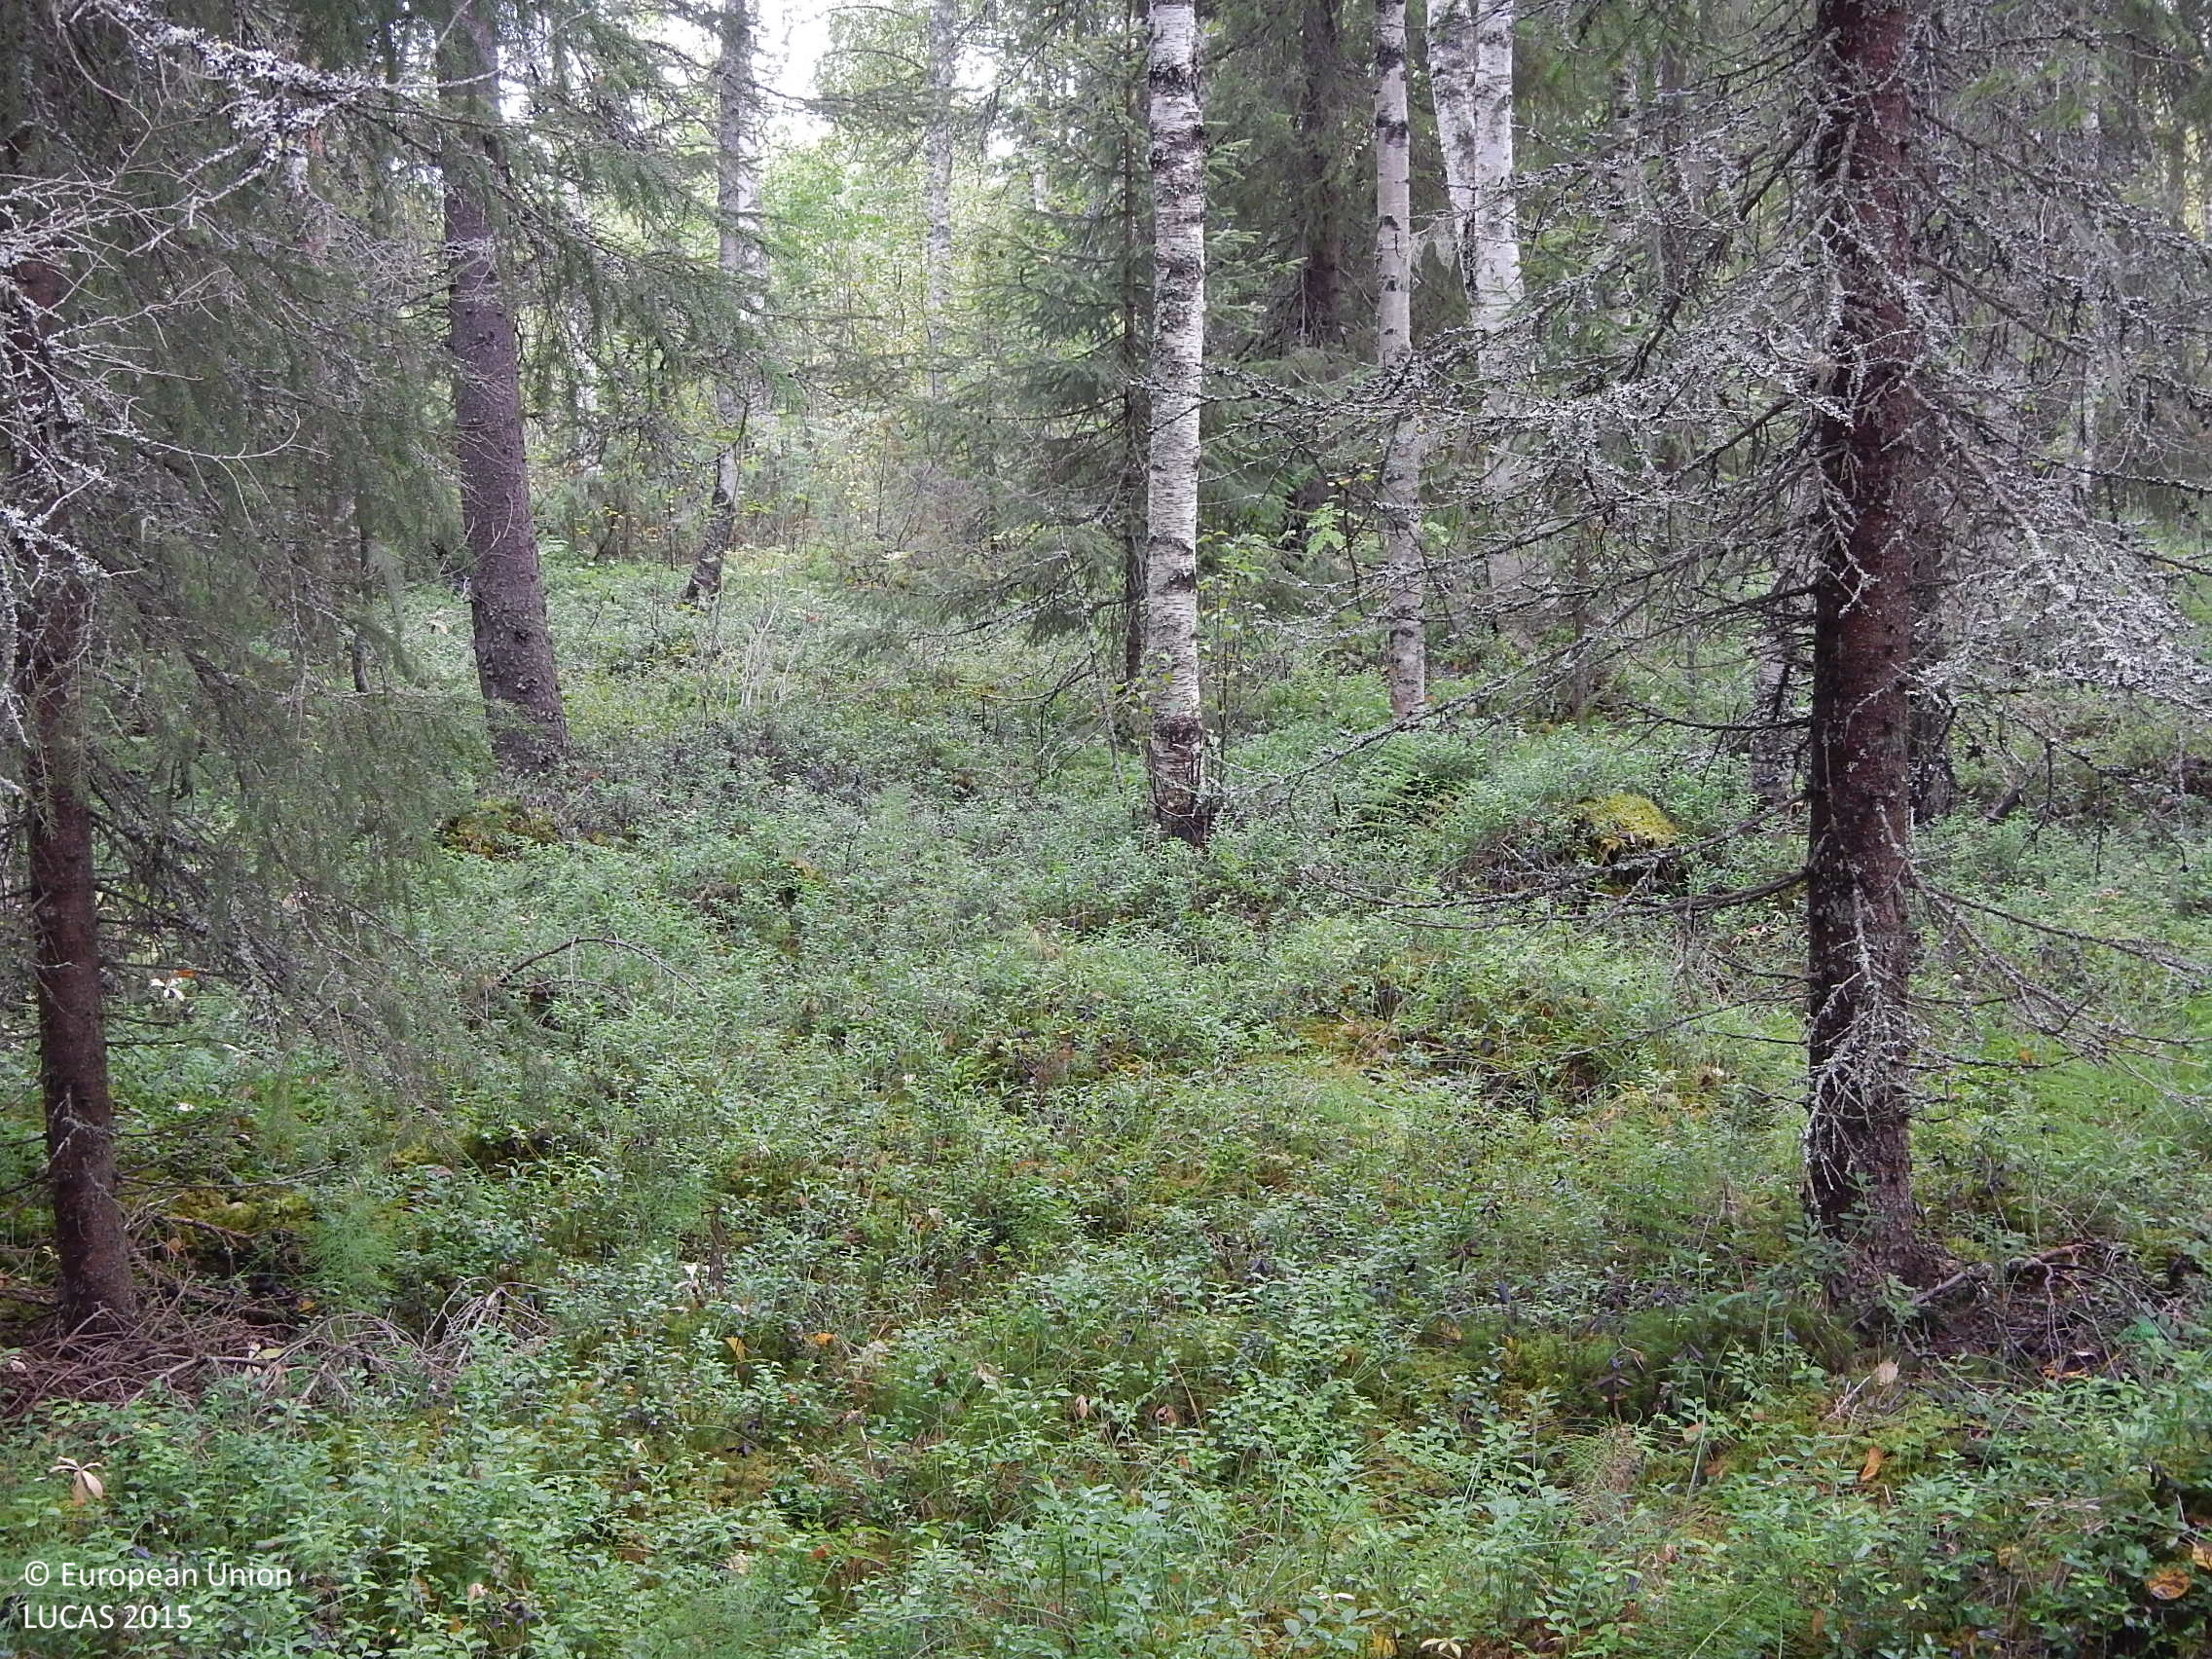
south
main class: Woodland
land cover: Spruce dominated mixed woodland
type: boreal forest
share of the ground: 50 - 75 %
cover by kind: coniferous forest trees 45 %, broadleaved forest trees 25 %, shrubs 25 %, lichens and mosses 5 %
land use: Forestry
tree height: > 5 m
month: August
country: FI
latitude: 65.7018
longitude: 27.3494
